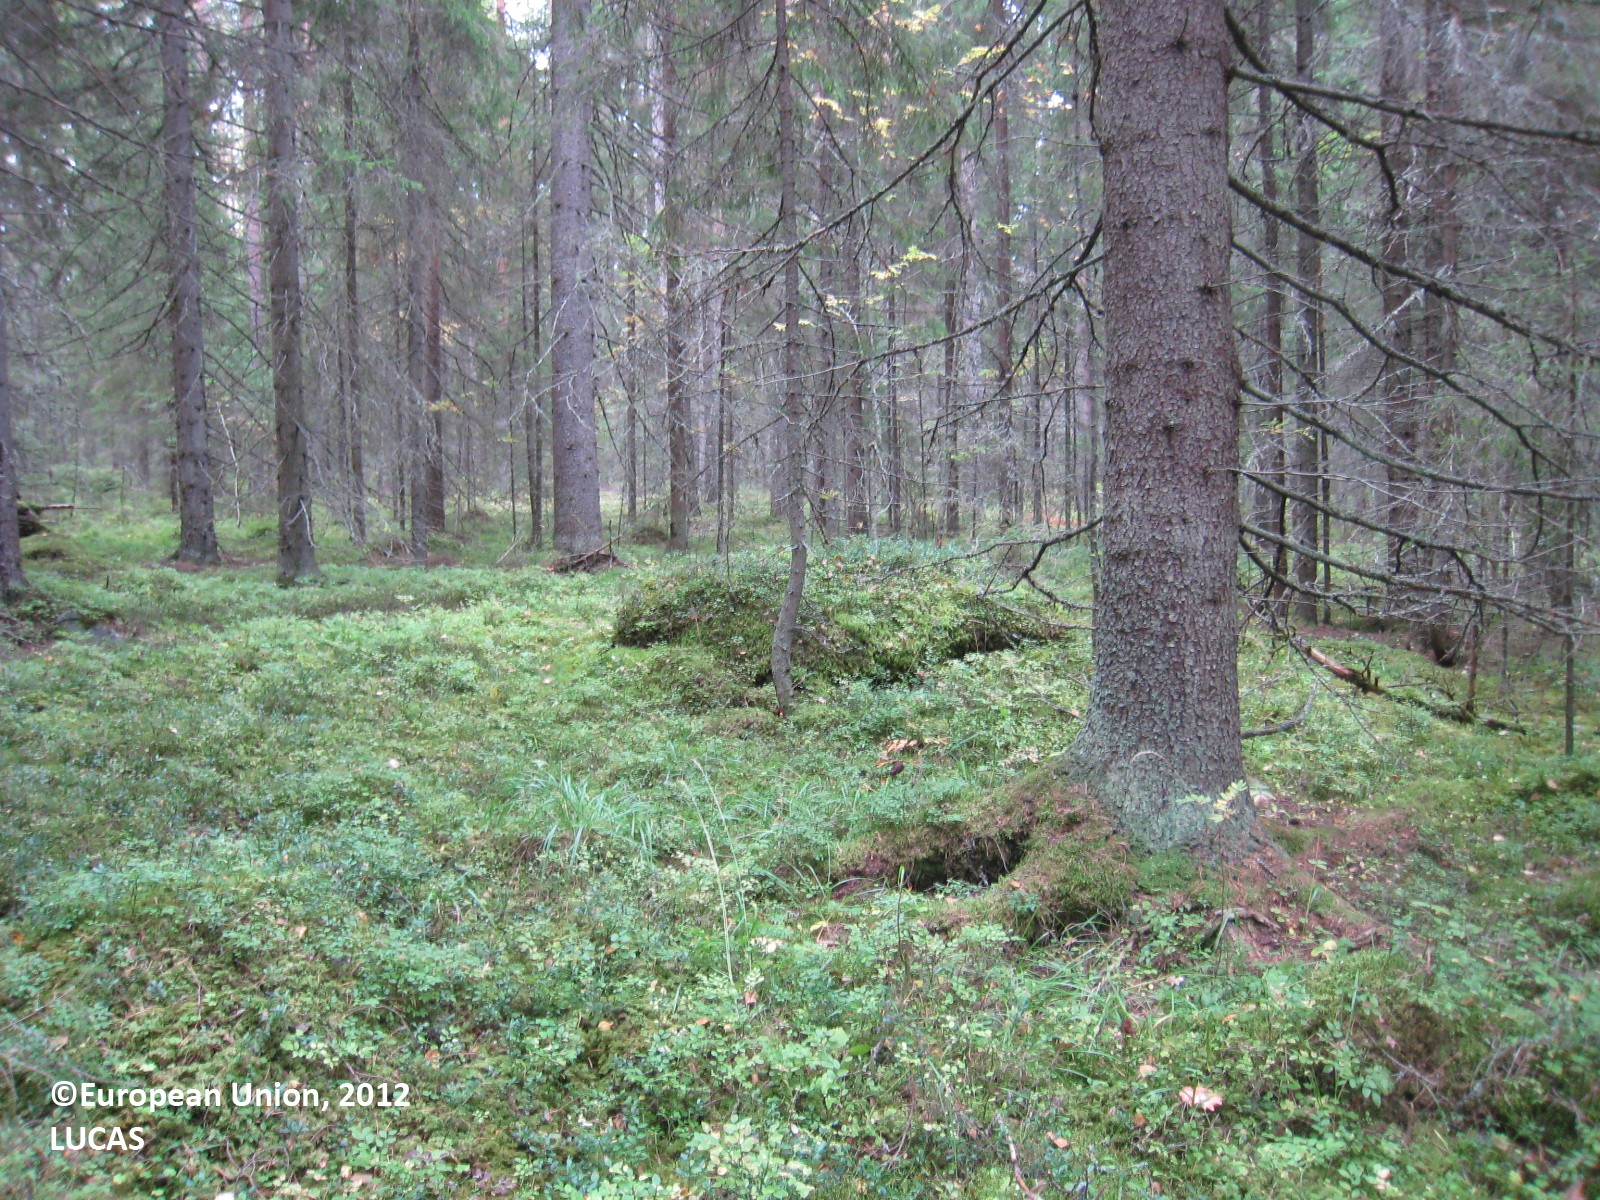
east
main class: Woodland
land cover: Spruce dominated coniferous woodland
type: boreal forest
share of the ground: > 75 %
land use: Forestry
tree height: > 5 m
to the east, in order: Spruce dominated coniferous woodland; Tracks; Other coniferous woodland; Spruce dominated coniferous woodland; Other coniferous woodland
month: September
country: FI
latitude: 62.7233
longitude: 26.5464
